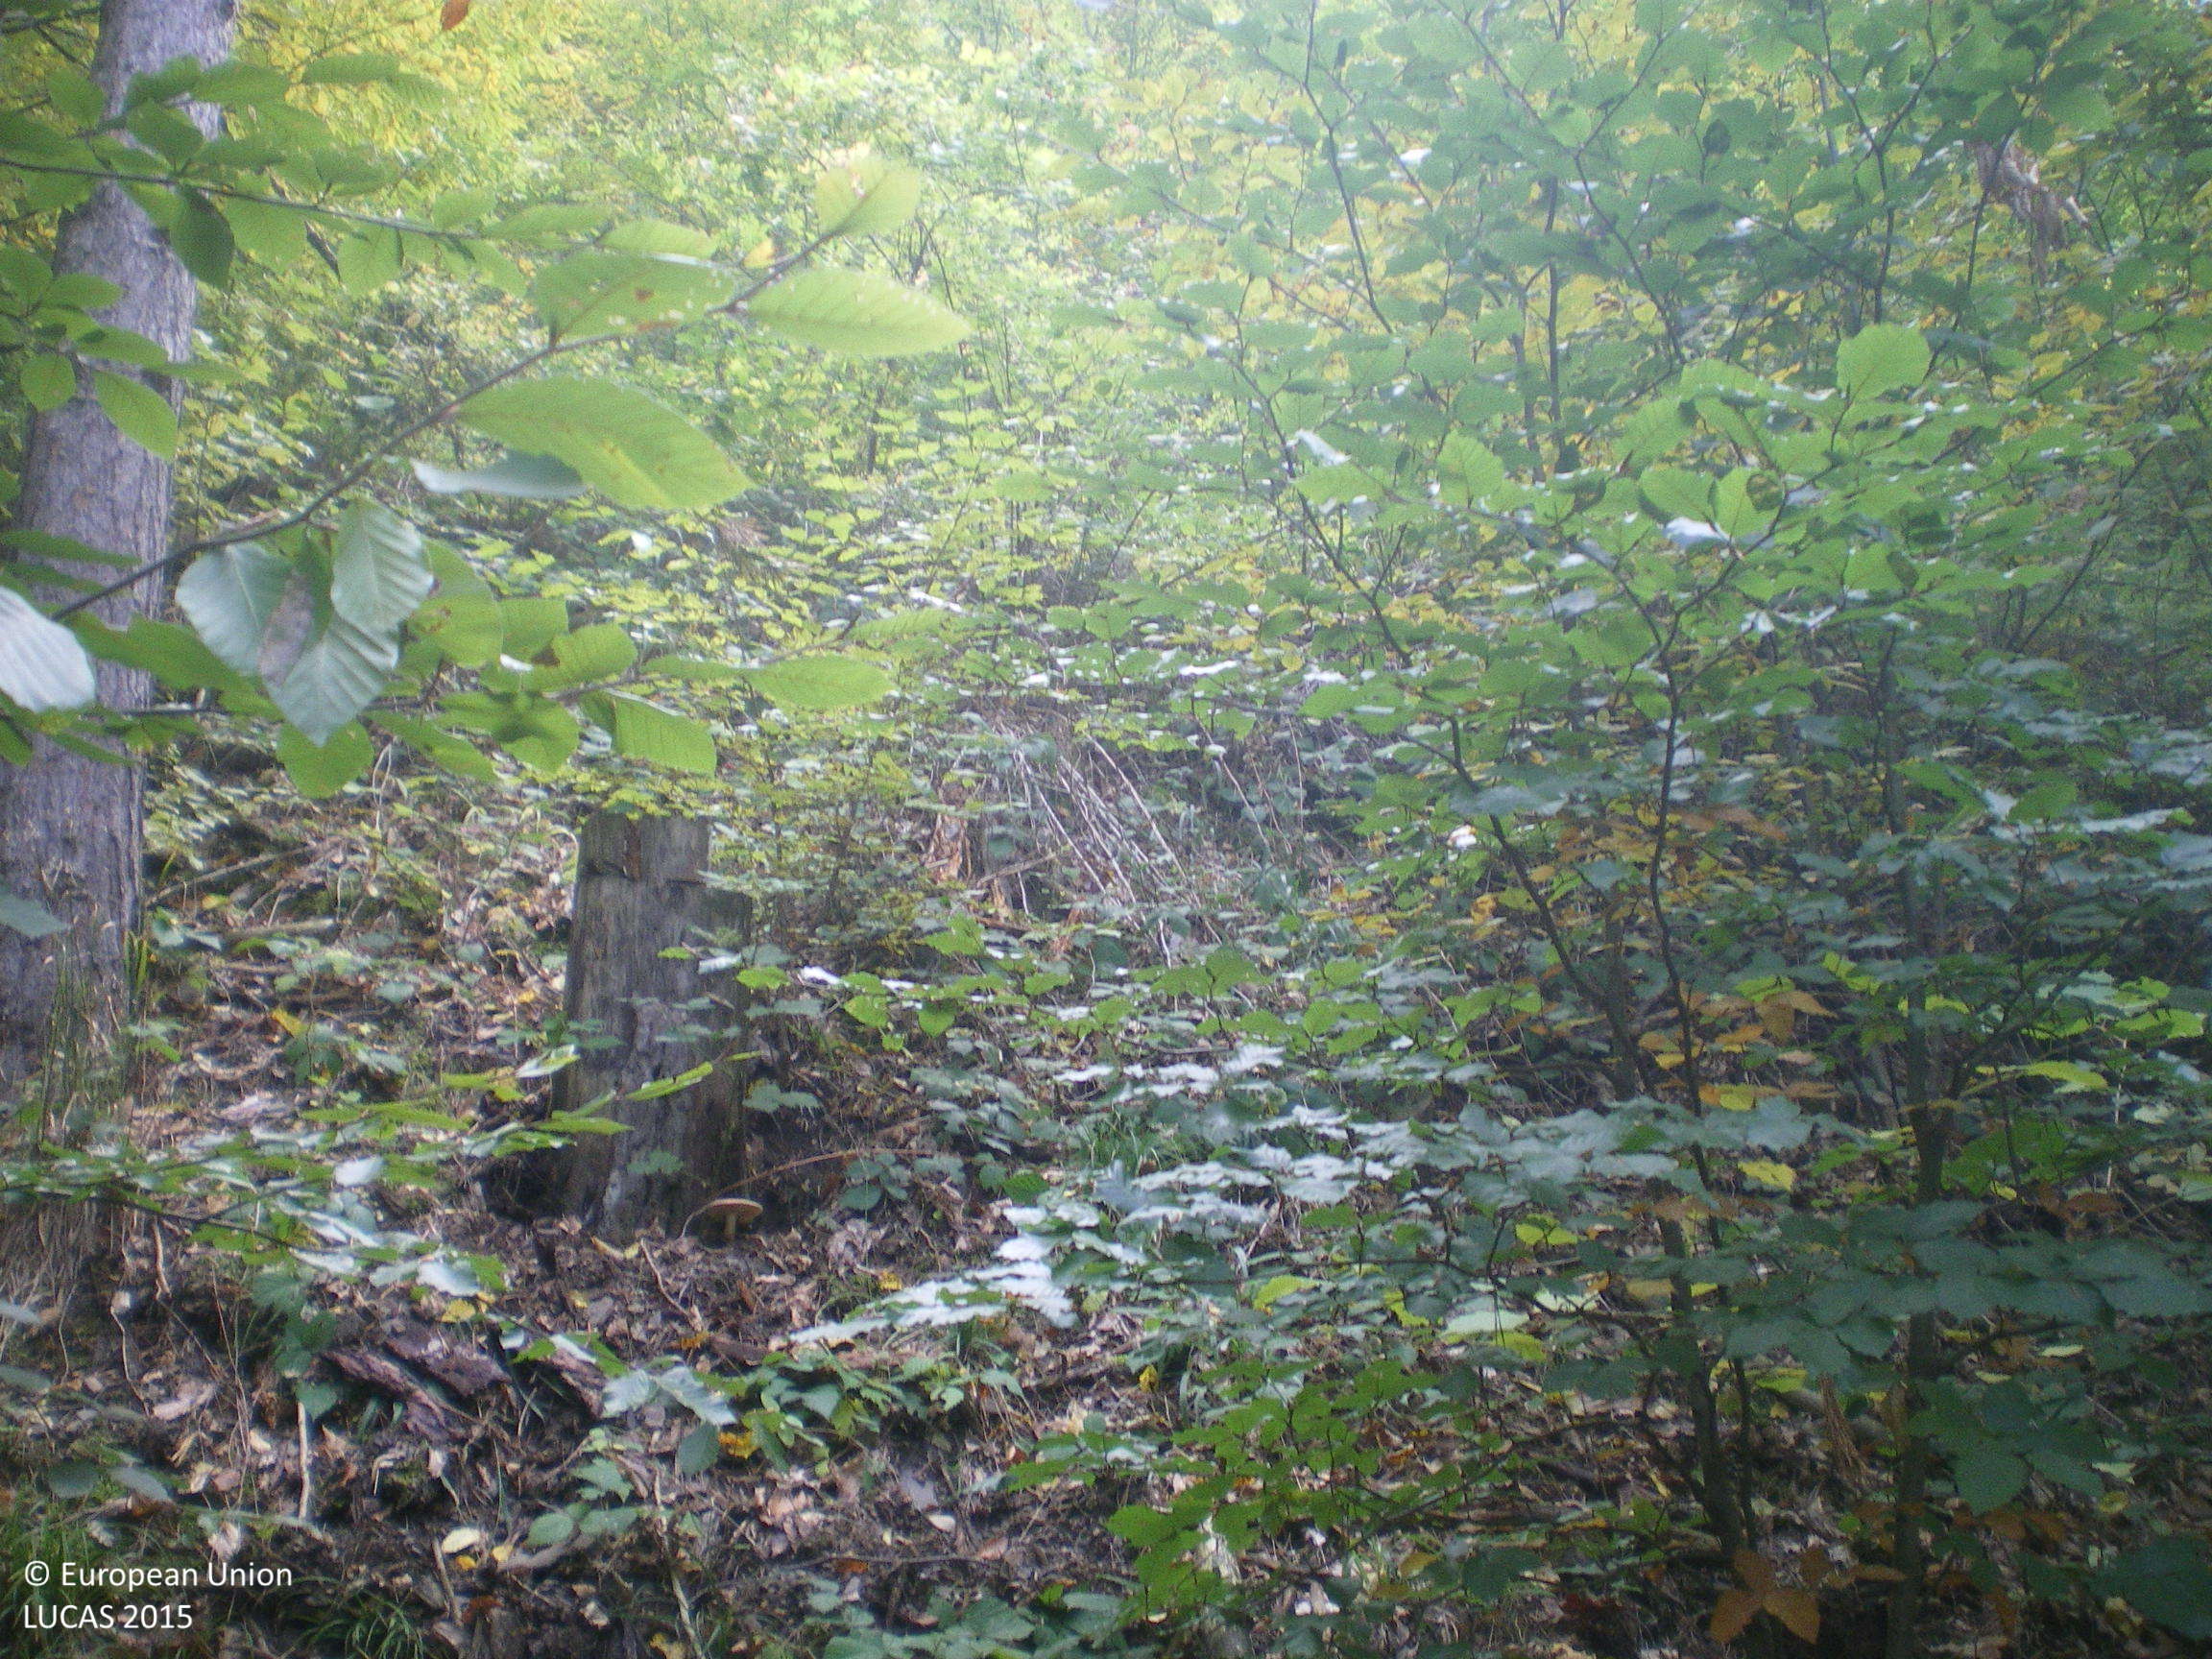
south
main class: Woodland
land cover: Pine dominated mixed woodland
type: hemiboreal forest and nemoral coniferous forest and mixed broadleaved-coniferous forest
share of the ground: > 75 %
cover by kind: coniferous forest trees 60 %, broadleaved forest trees 25 %, shrubs 15 %
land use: Forestry
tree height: > 5 m
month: October
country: BG
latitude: 42.7287
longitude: 25.6726
